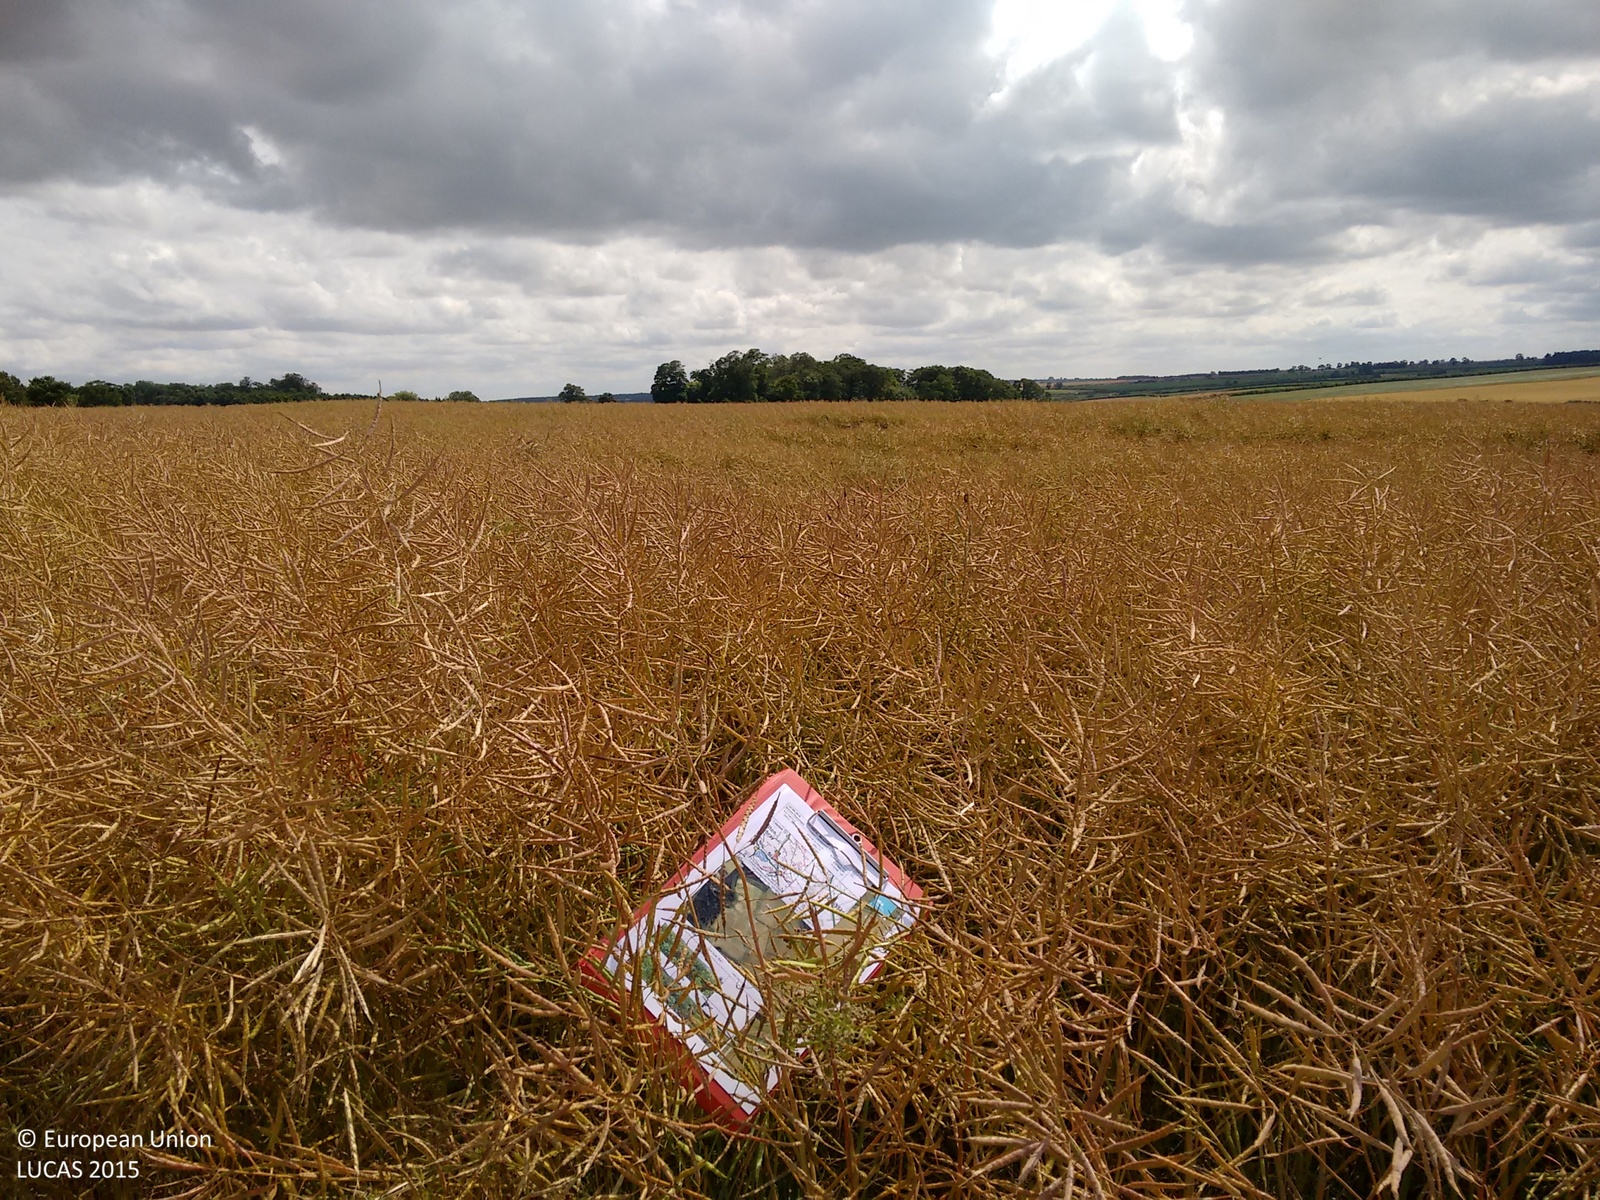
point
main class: Cropland
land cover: Rape and turnip rape
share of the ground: > 75 %
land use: Agriculture (excluding fallow land and kitchen gardens)
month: July
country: GB
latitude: 52.7004
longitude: -0.5902
